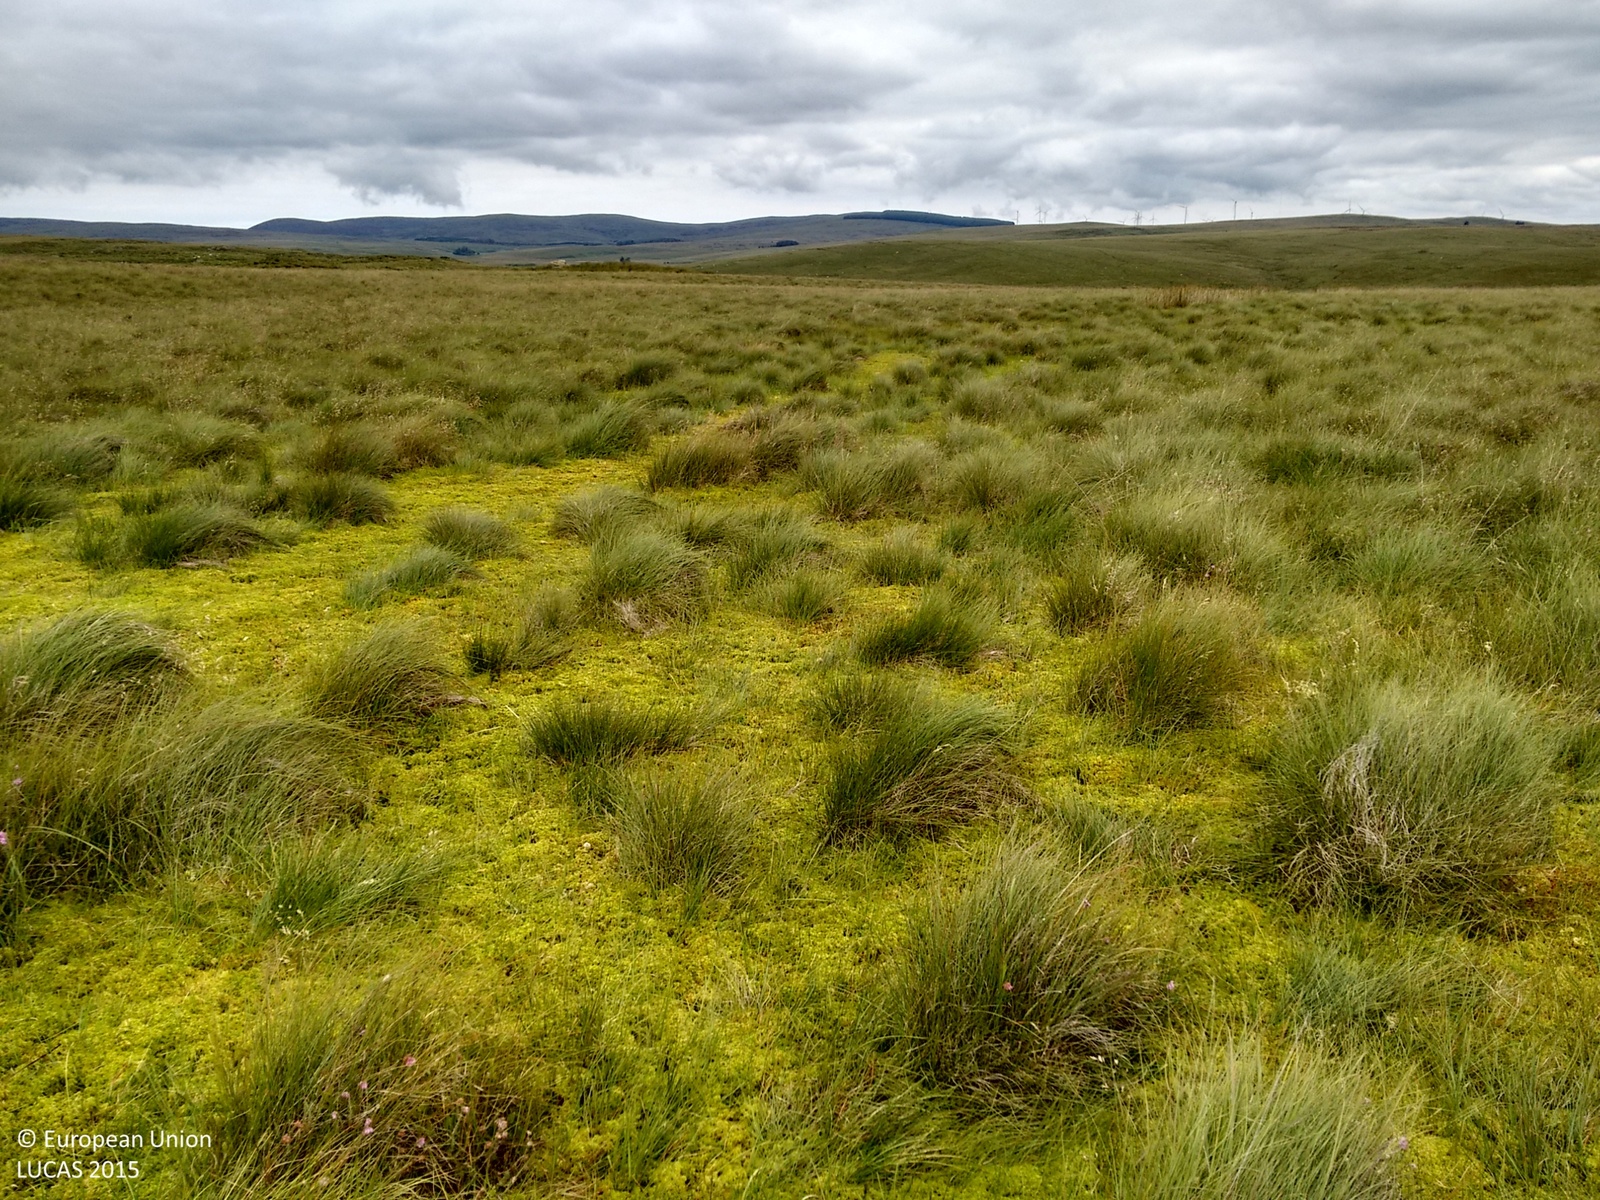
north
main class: Grassland
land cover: Grassland without tree/shrub cover
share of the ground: > 75 %
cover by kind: herbaceous plants 70 %, lichens and mosses 30 %
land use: Agriculture (excluding fallow land and kitchen gardens)
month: August
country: GB
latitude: 55.0012
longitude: -4.8843
